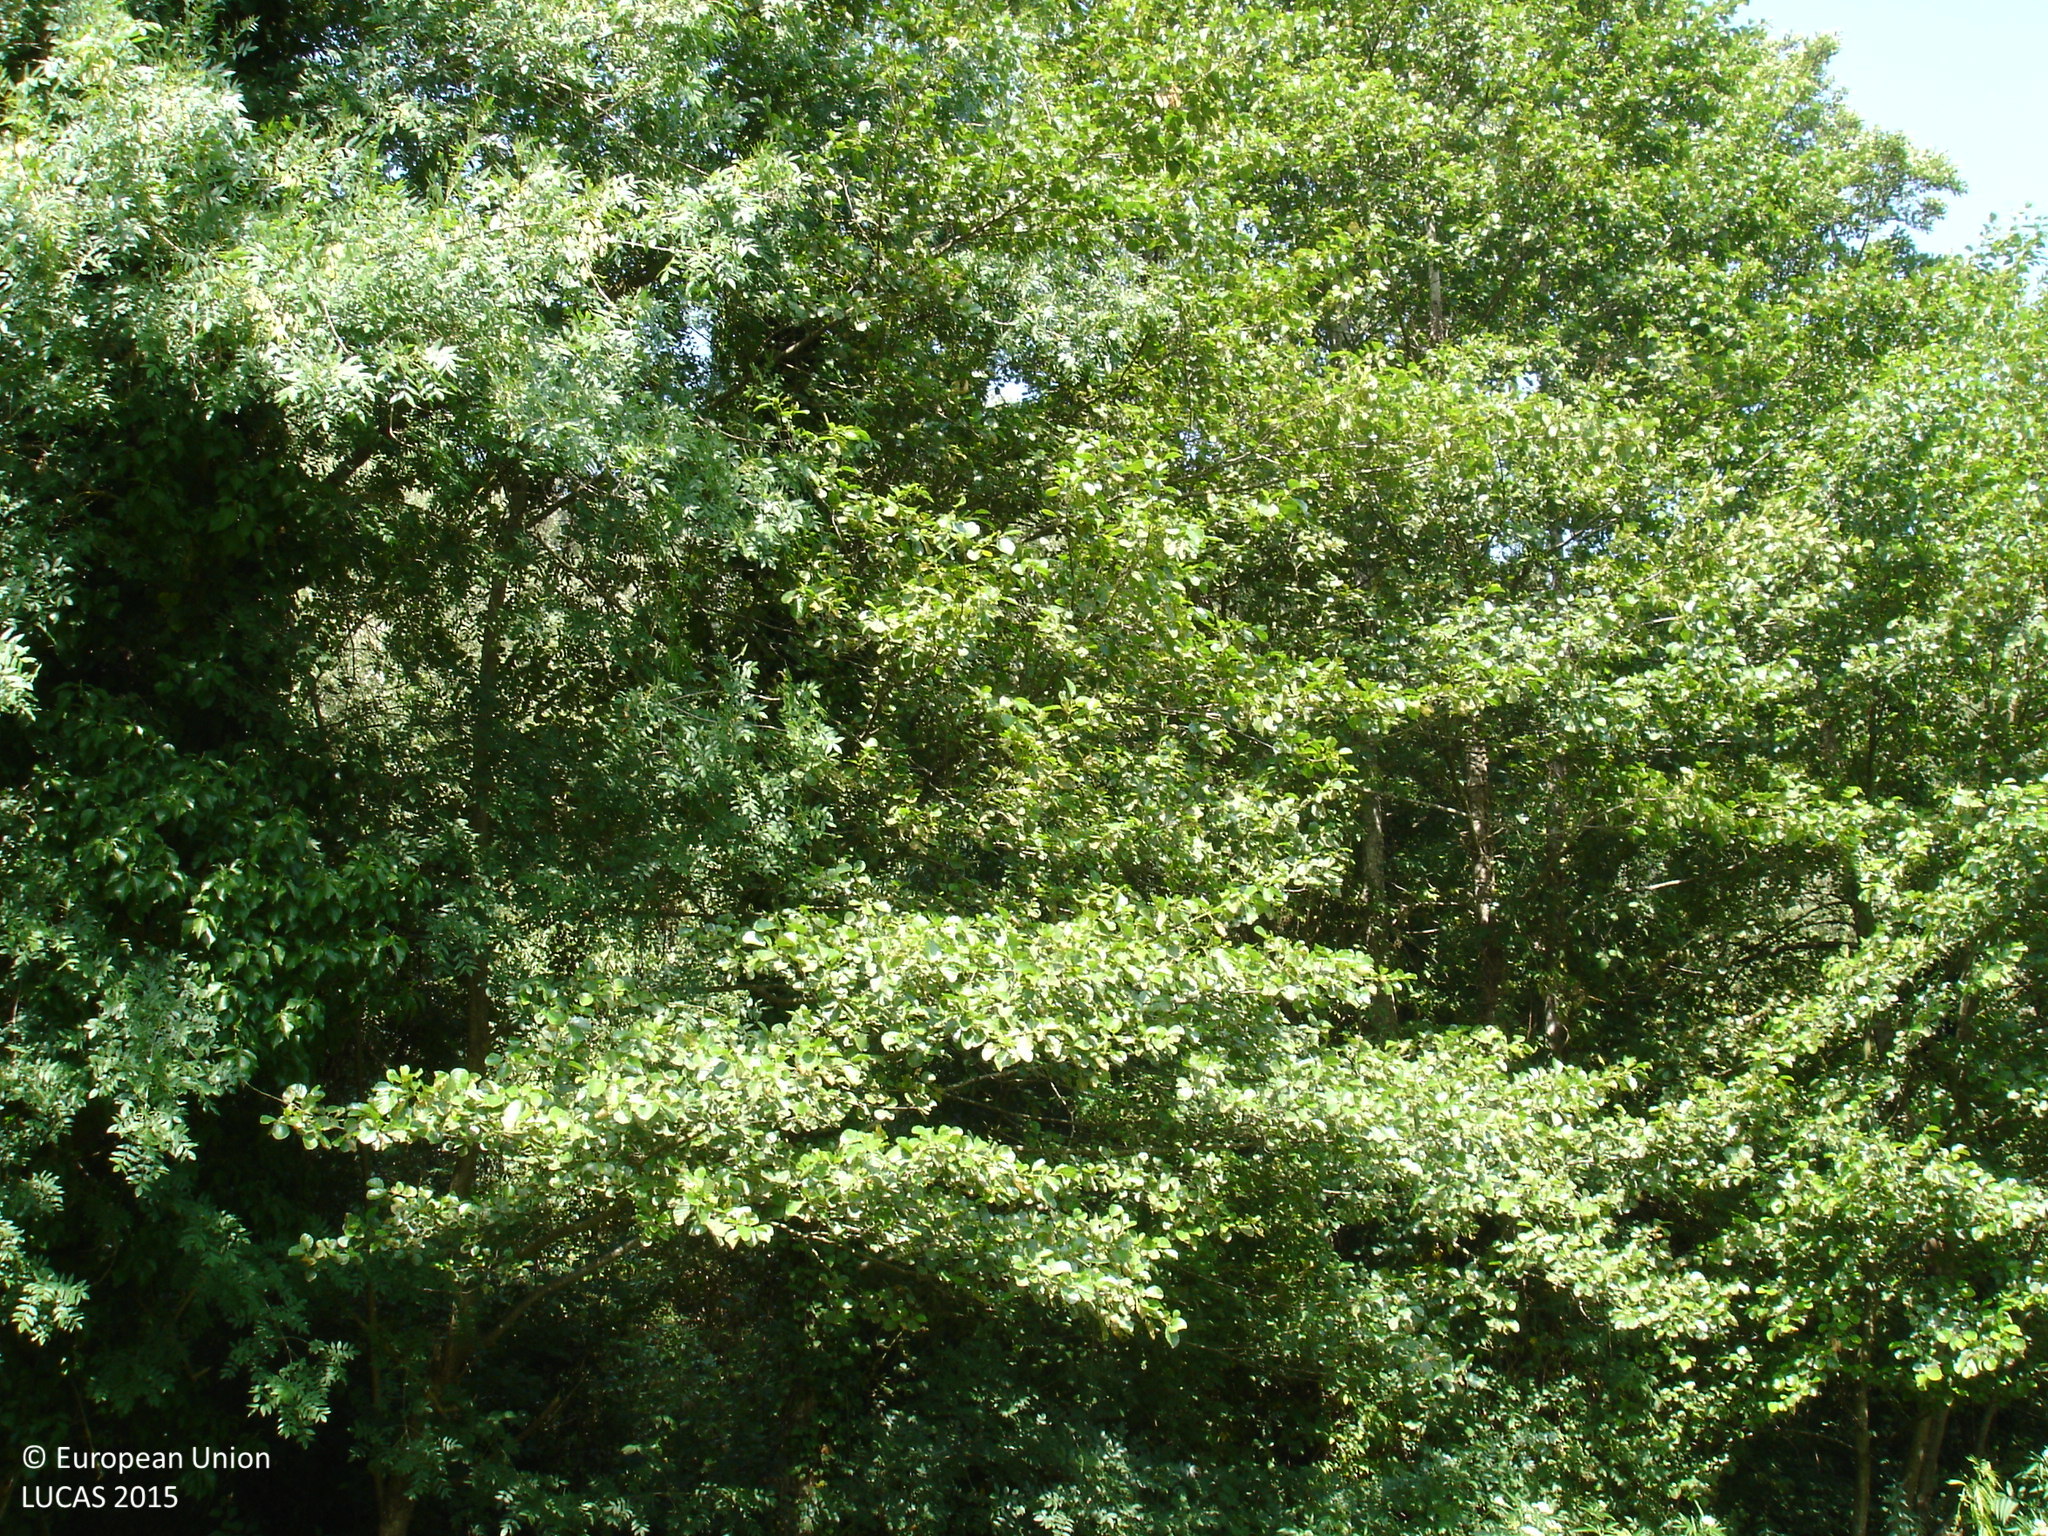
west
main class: Grassland
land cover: Grassland with sparse tree/shrub cover
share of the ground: > 75 %
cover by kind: herbaceous plants 90 %, broadleaved forest trees 5 %, consolidated bare surface 5 %
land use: Semi-natural and natural areas not in use
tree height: > 5 m
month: July
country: ES
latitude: 41.9949
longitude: 3.0020
